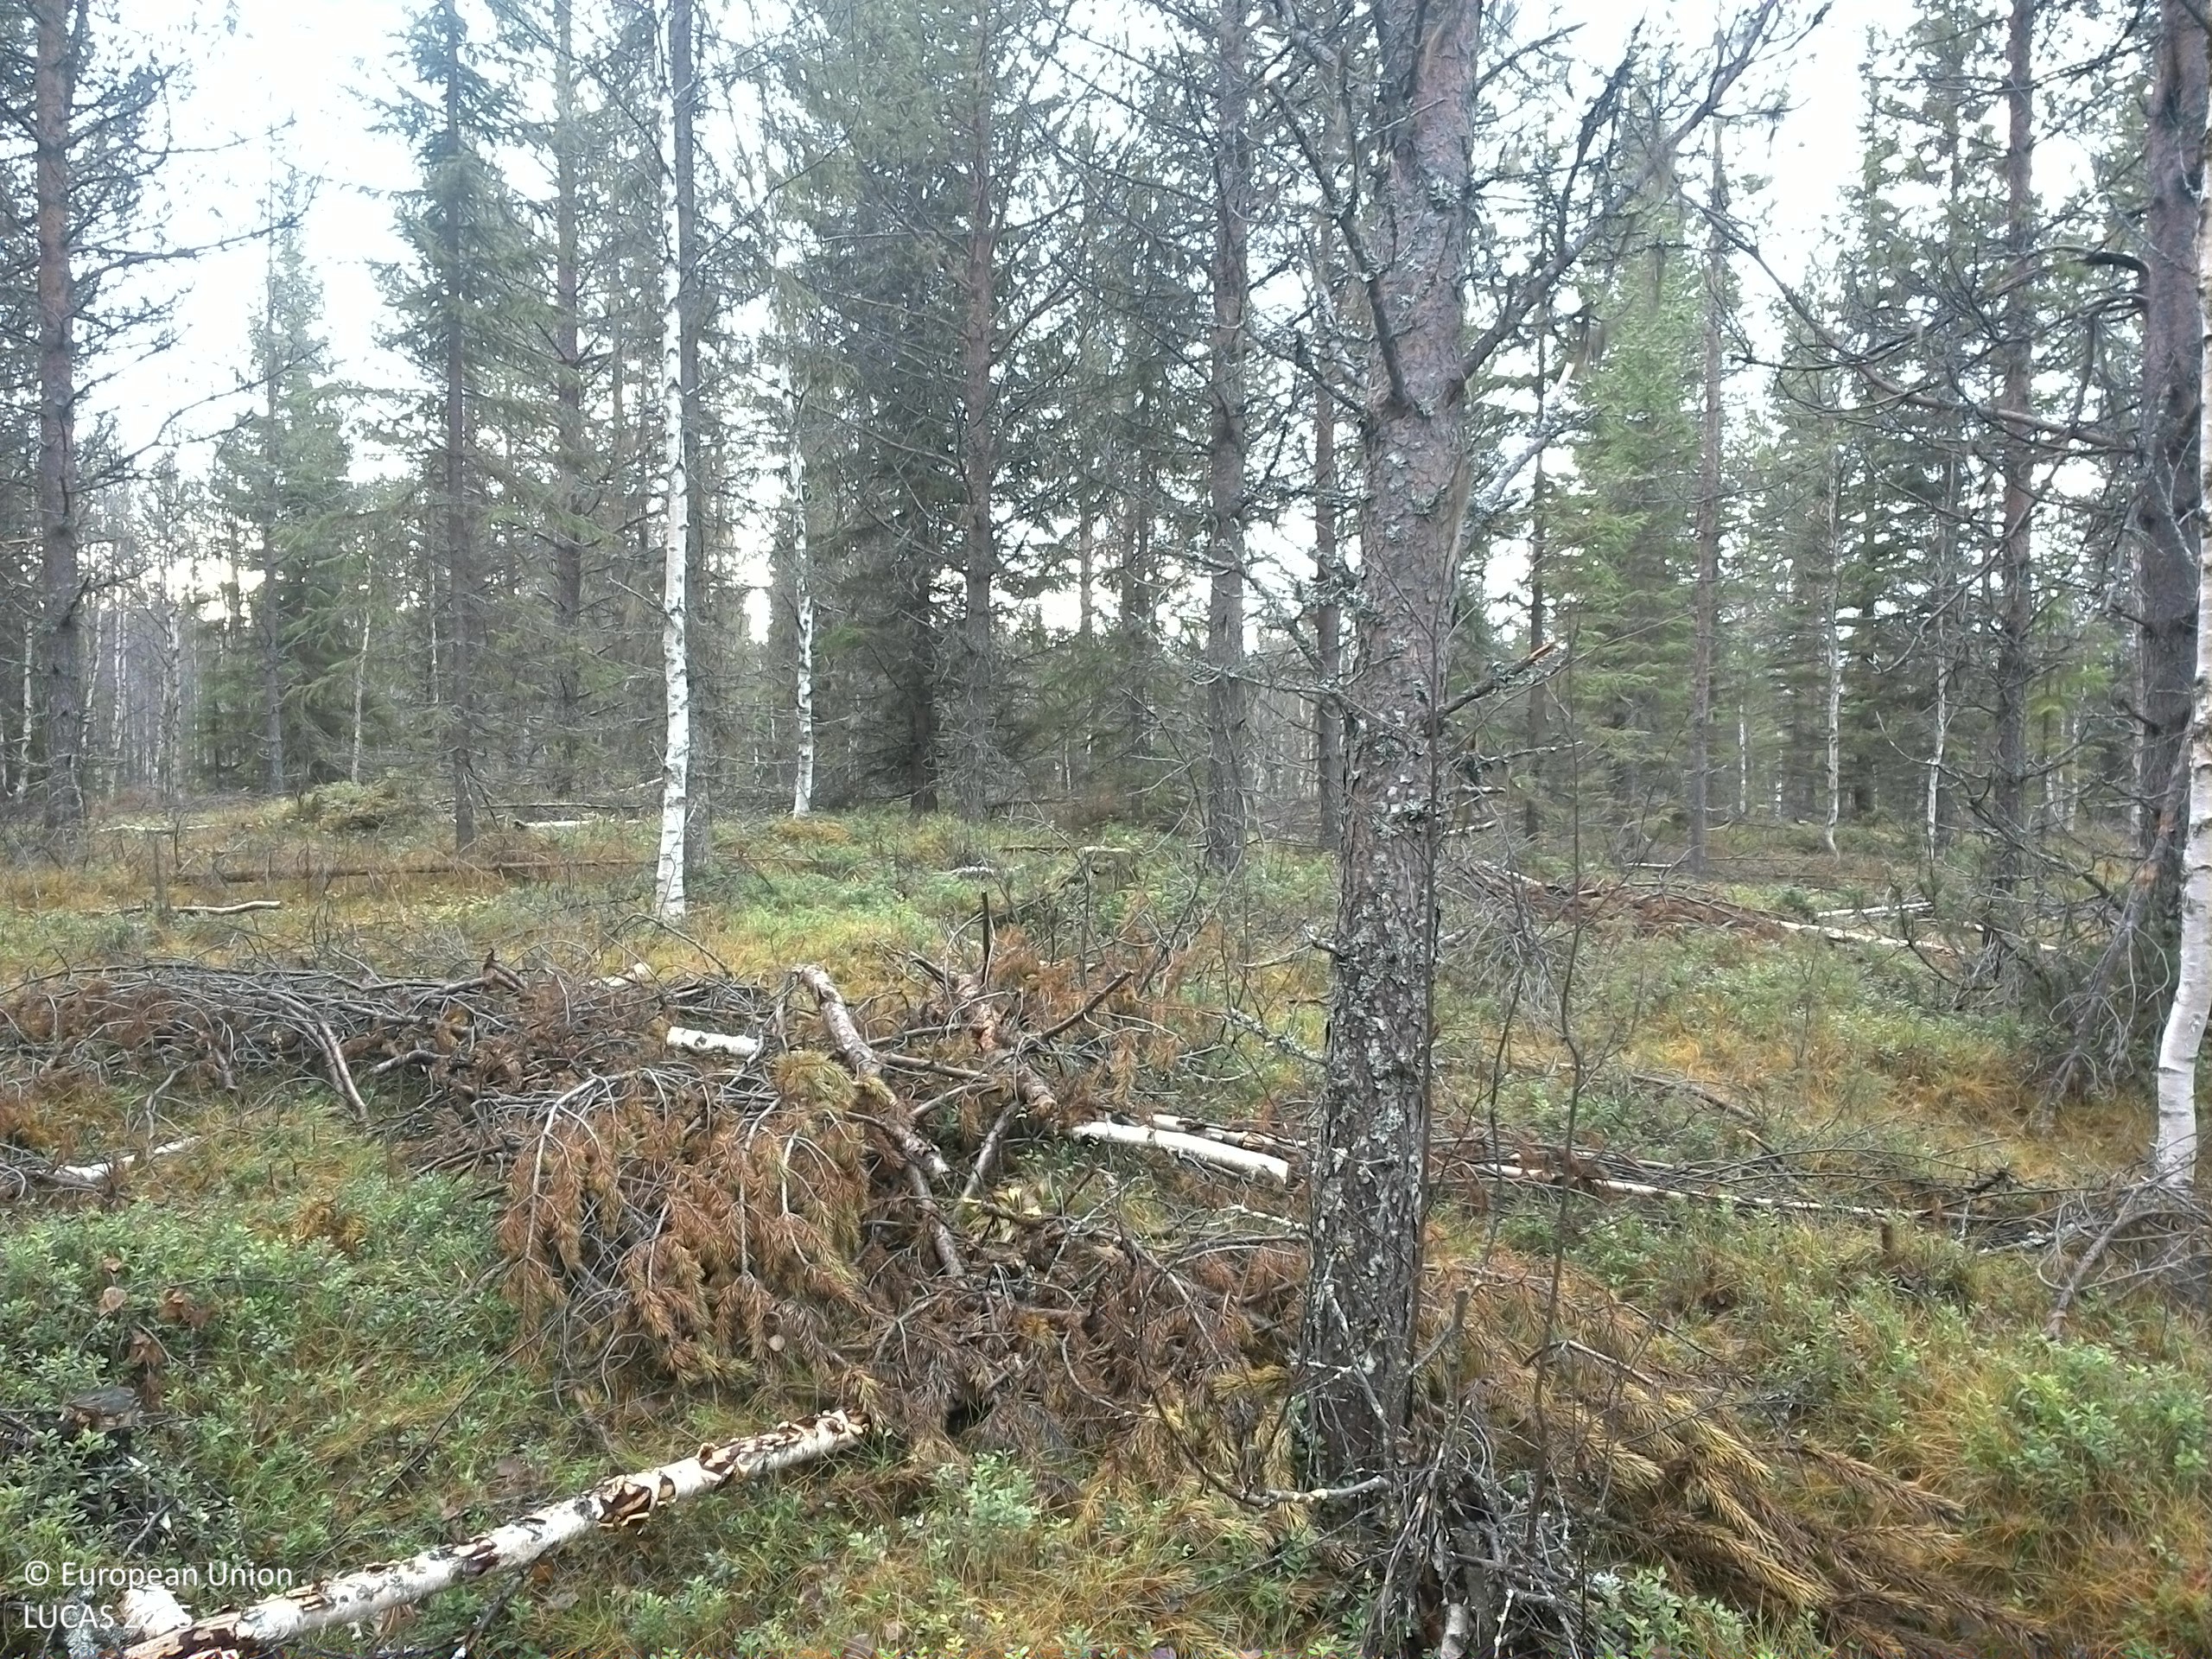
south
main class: Woodland
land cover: Pine dominated mixed woodland
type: boreal forest
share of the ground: 50 - 75 %
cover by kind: coniferous forest trees 35 %, shrubs 20 %, broadleaved forest trees 15 %, herbaceous plants 15 %, lichens and mosses 15 %
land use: Forestry
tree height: > 5 m
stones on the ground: 25 - 50 %
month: October
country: SE
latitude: 63.9144
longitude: 15.2124
